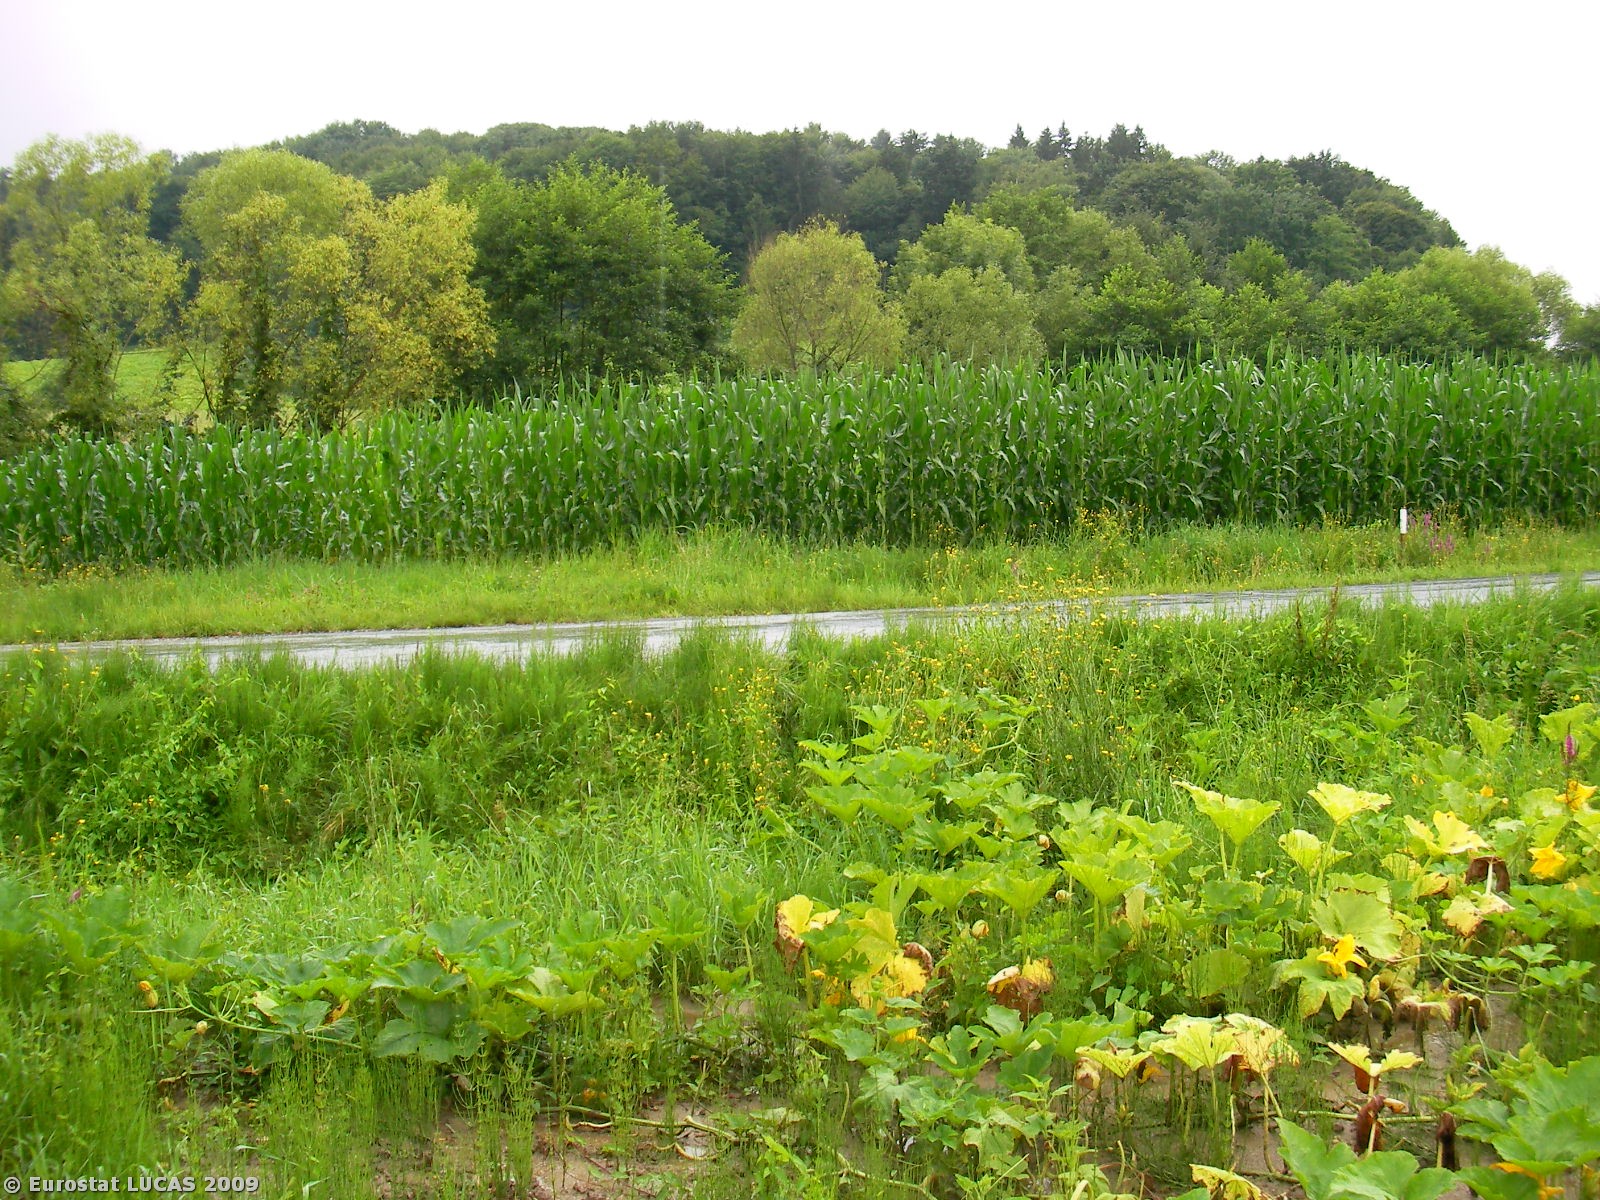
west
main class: Cropland
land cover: Other fibre and oleaginous crops
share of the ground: > 75 %
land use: Agriculture (excluding fallow land and kitchen gardens)
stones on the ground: < 10 %
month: July
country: AT
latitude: 46.9386
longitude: 15.7144
